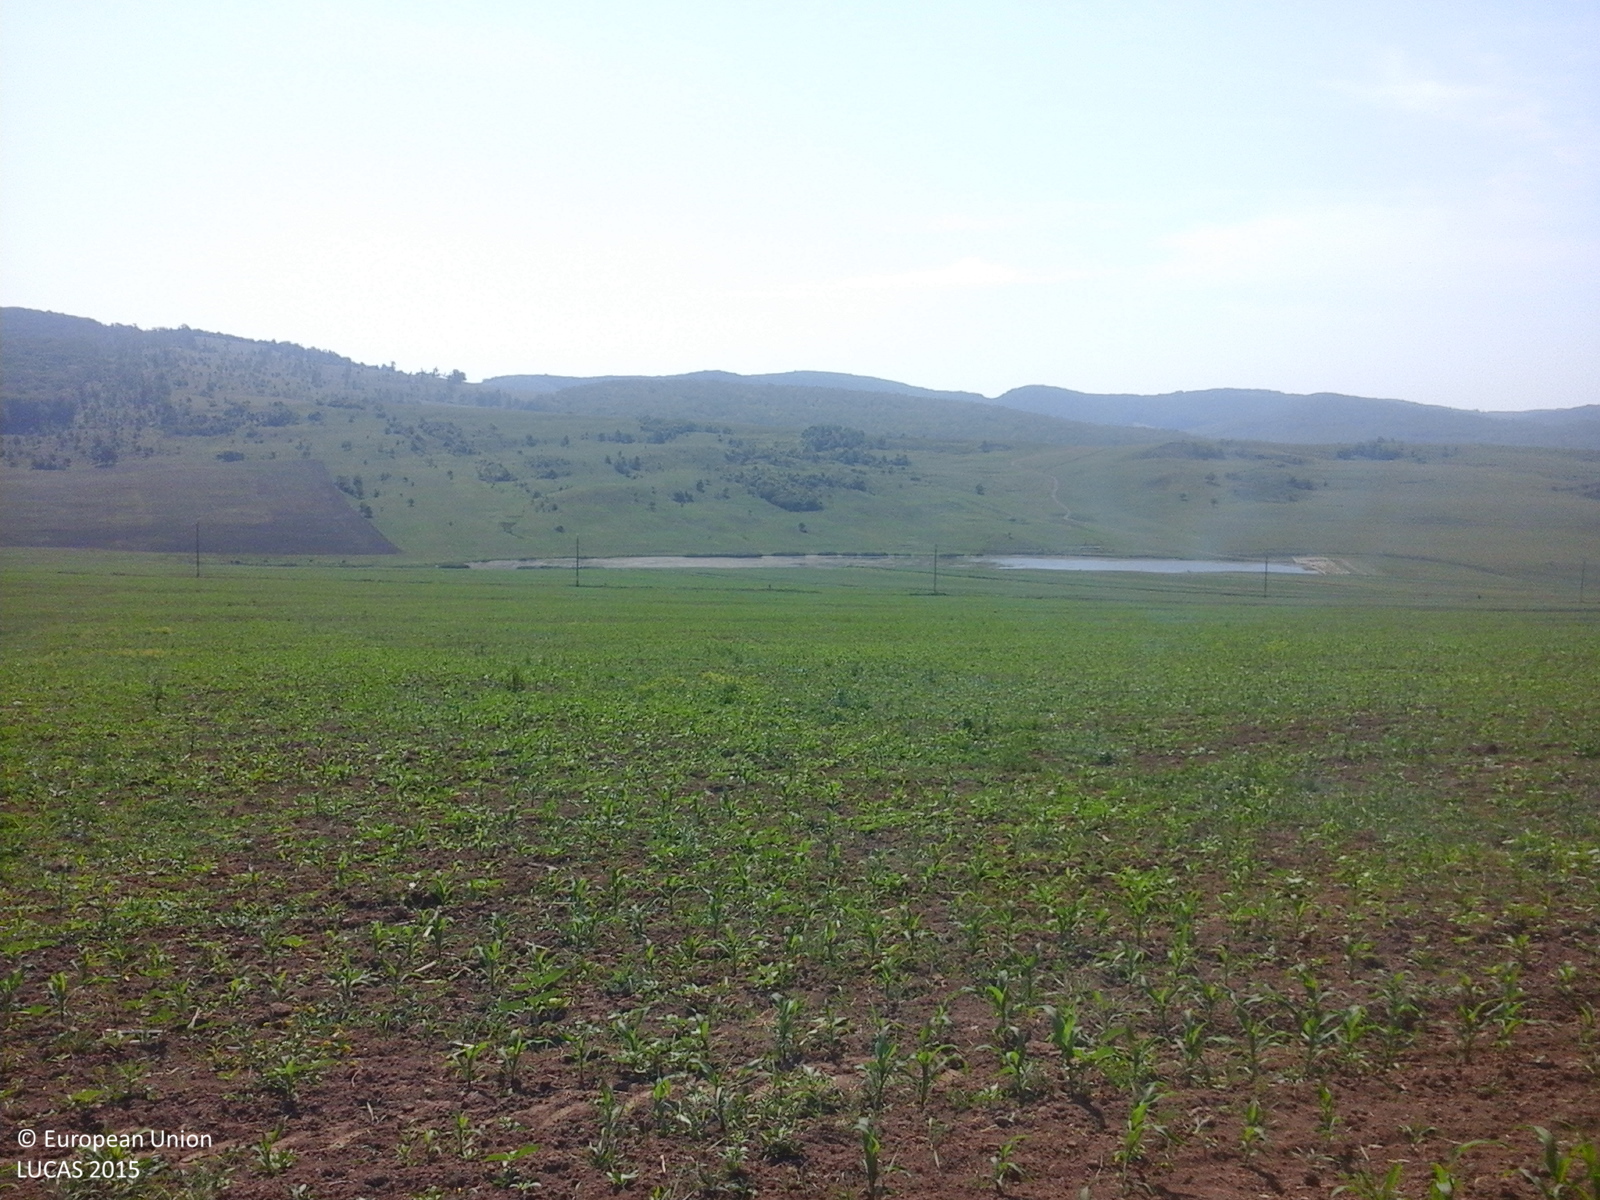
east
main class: Cropland
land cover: Maize
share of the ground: 10 - 25 %
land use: Agriculture (excluding fallow land and kitchen gardens)
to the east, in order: Maize
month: June
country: RO
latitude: 46.5793
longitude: 27.1026
